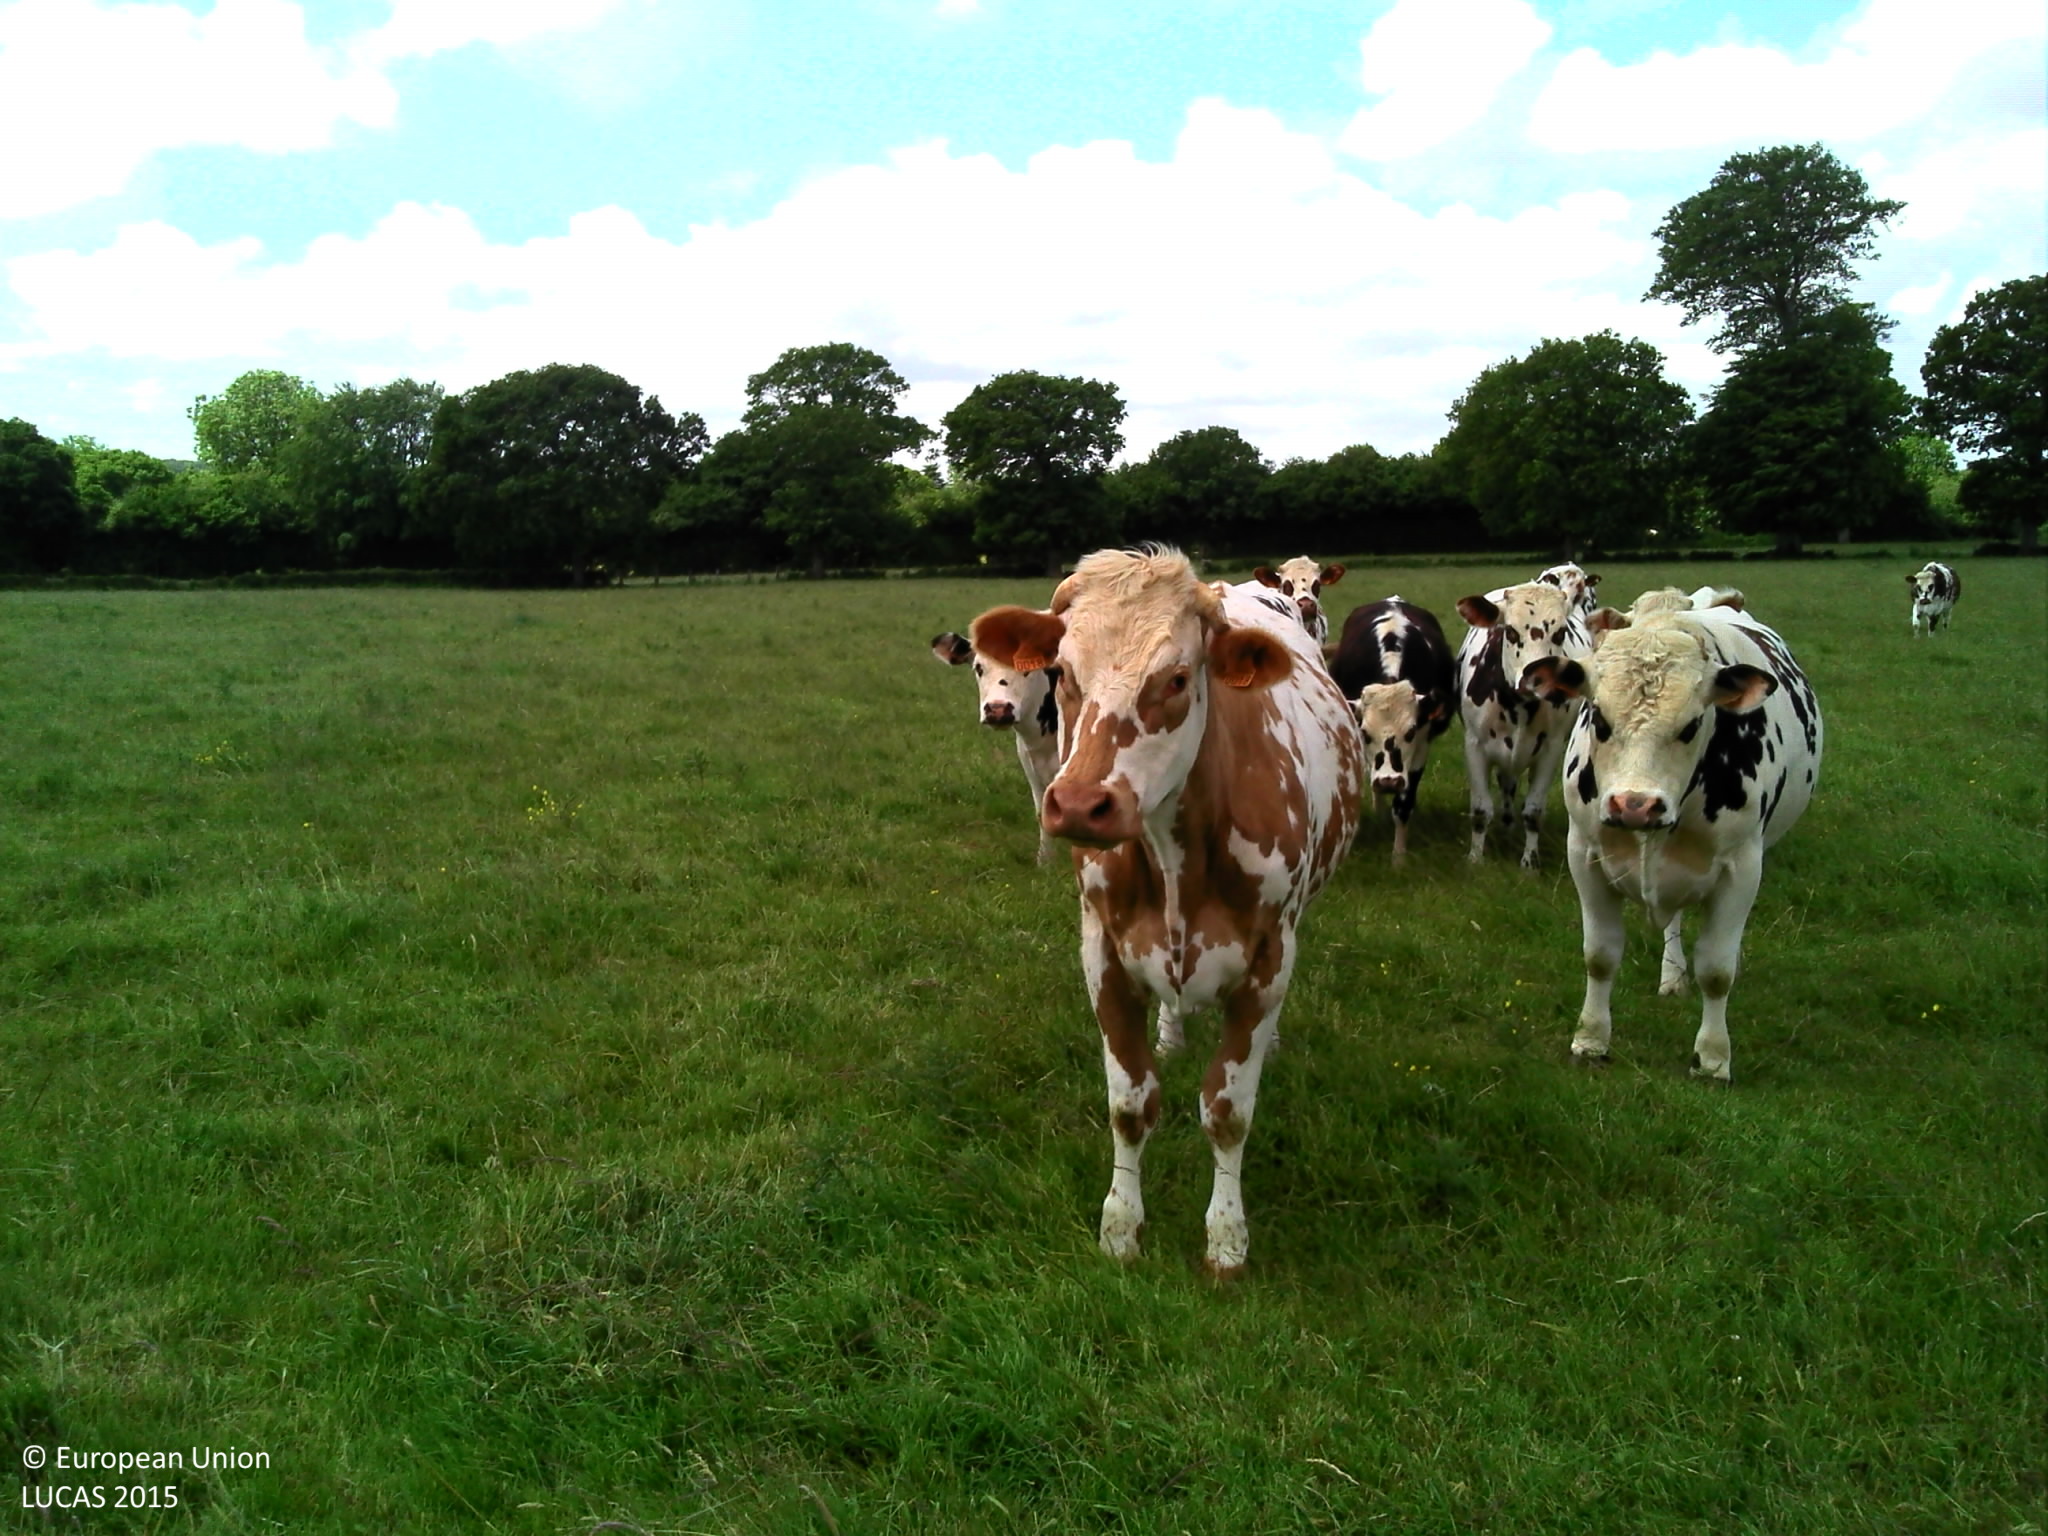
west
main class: Grassland
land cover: Grassland without tree/shrub cover
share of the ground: > 75 %
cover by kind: herbaceous plants 100 %
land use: Agriculture (excluding fallow land and kitchen gardens)
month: June
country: FR
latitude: 49.5710
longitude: -1.4291
